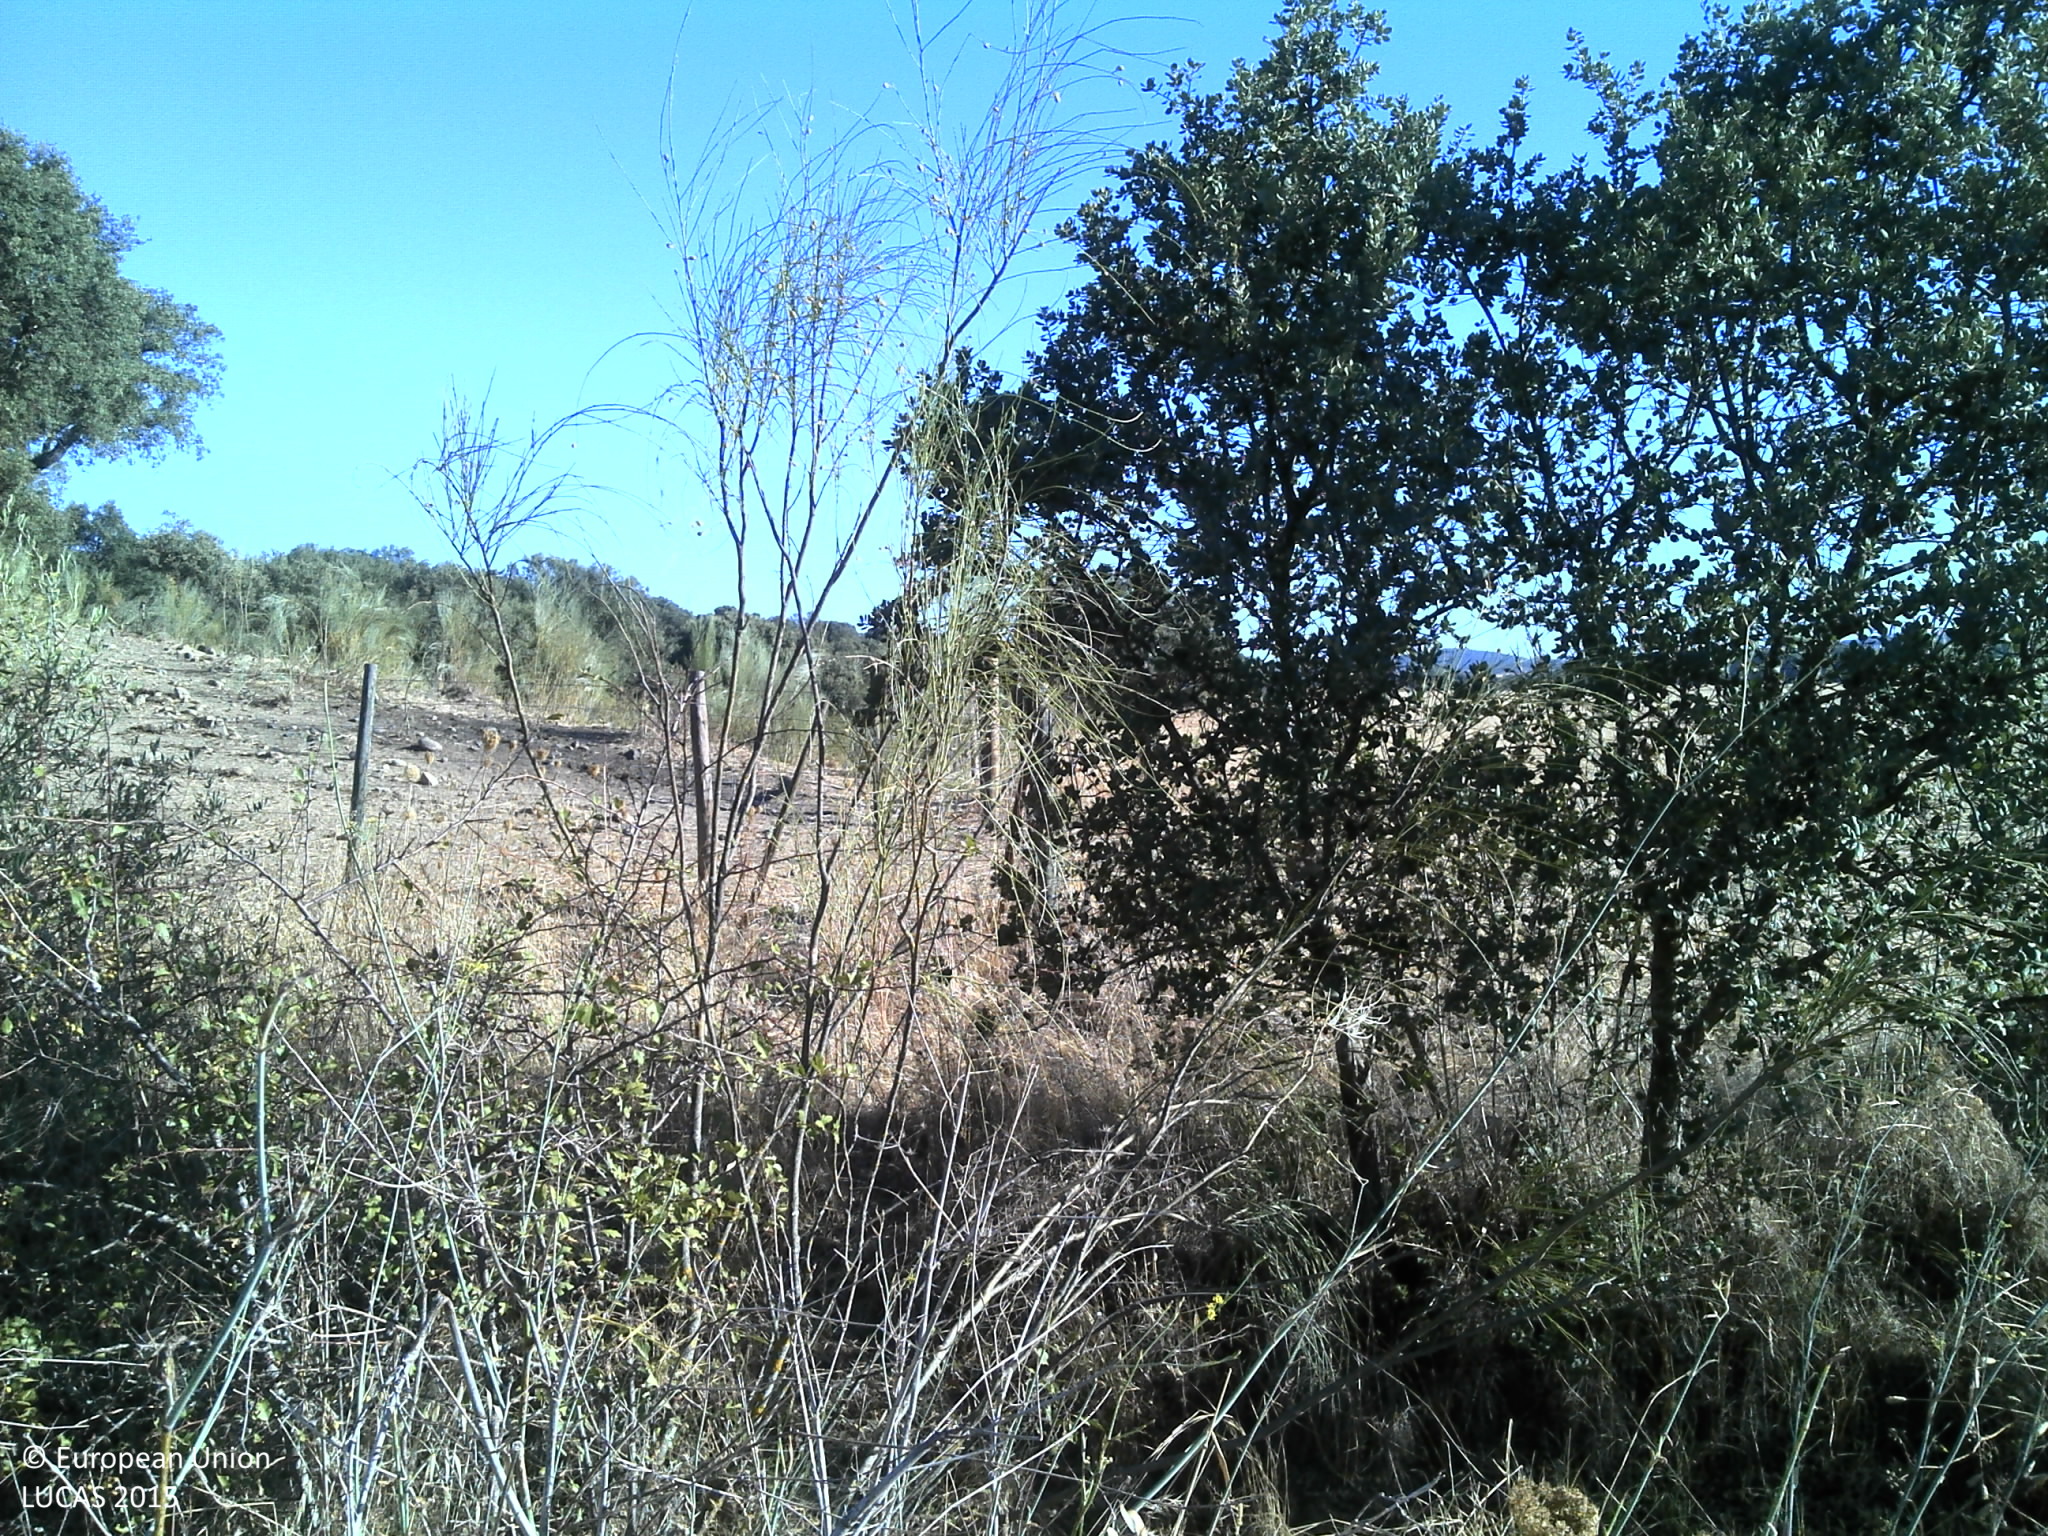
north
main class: Cropland
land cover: Olive groves
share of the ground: 25 - 50 %
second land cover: Shrubland without tree cover
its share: 10 - 25 %
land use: Agriculture (excluding fallow land and kitchen gardens)
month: July
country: PT
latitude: 39.0967
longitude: -7.0374
